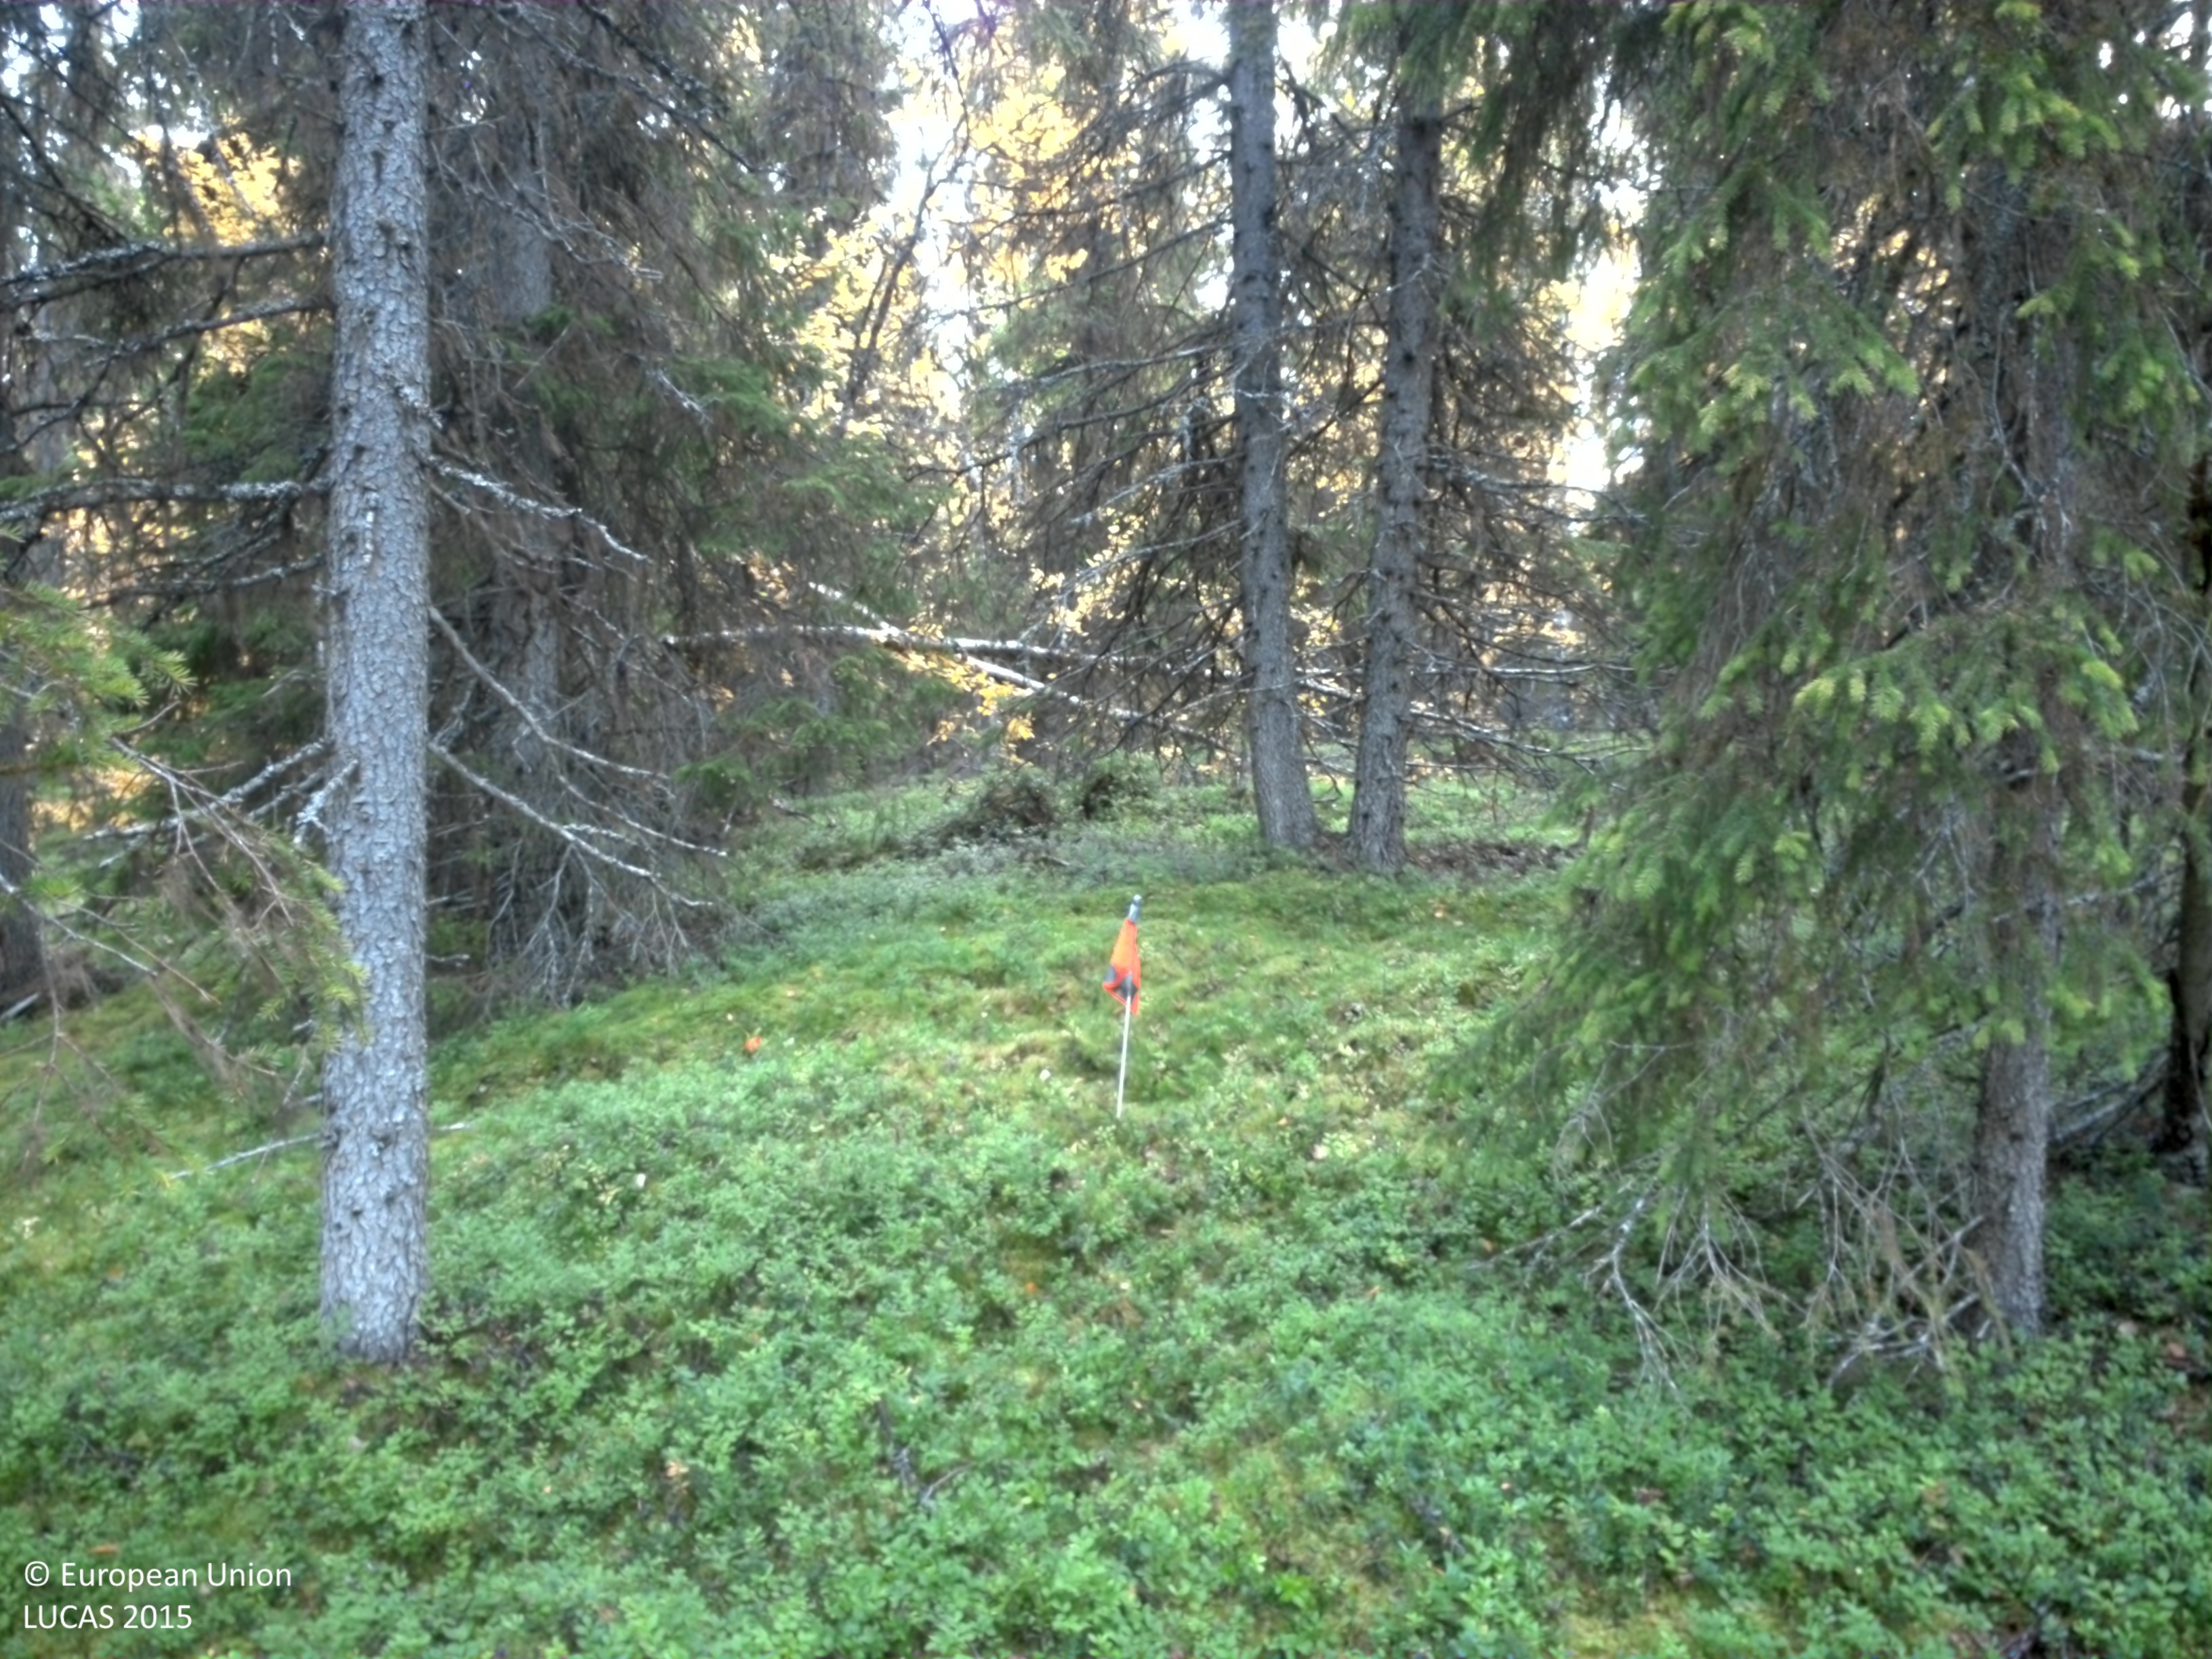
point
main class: Woodland
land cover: Spruce dominated mixed woodland
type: boreal forest
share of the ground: 25 - 50 %
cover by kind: shrubs 35 %, lichens and mosses 30 %, coniferous forest trees 20 %, broadleaved forest trees 10 %, herbaceous plants 5 %
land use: Forestry
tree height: > 5 m
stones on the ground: 10 - 25 %
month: September
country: SE
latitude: 65.1462
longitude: 16.6802
